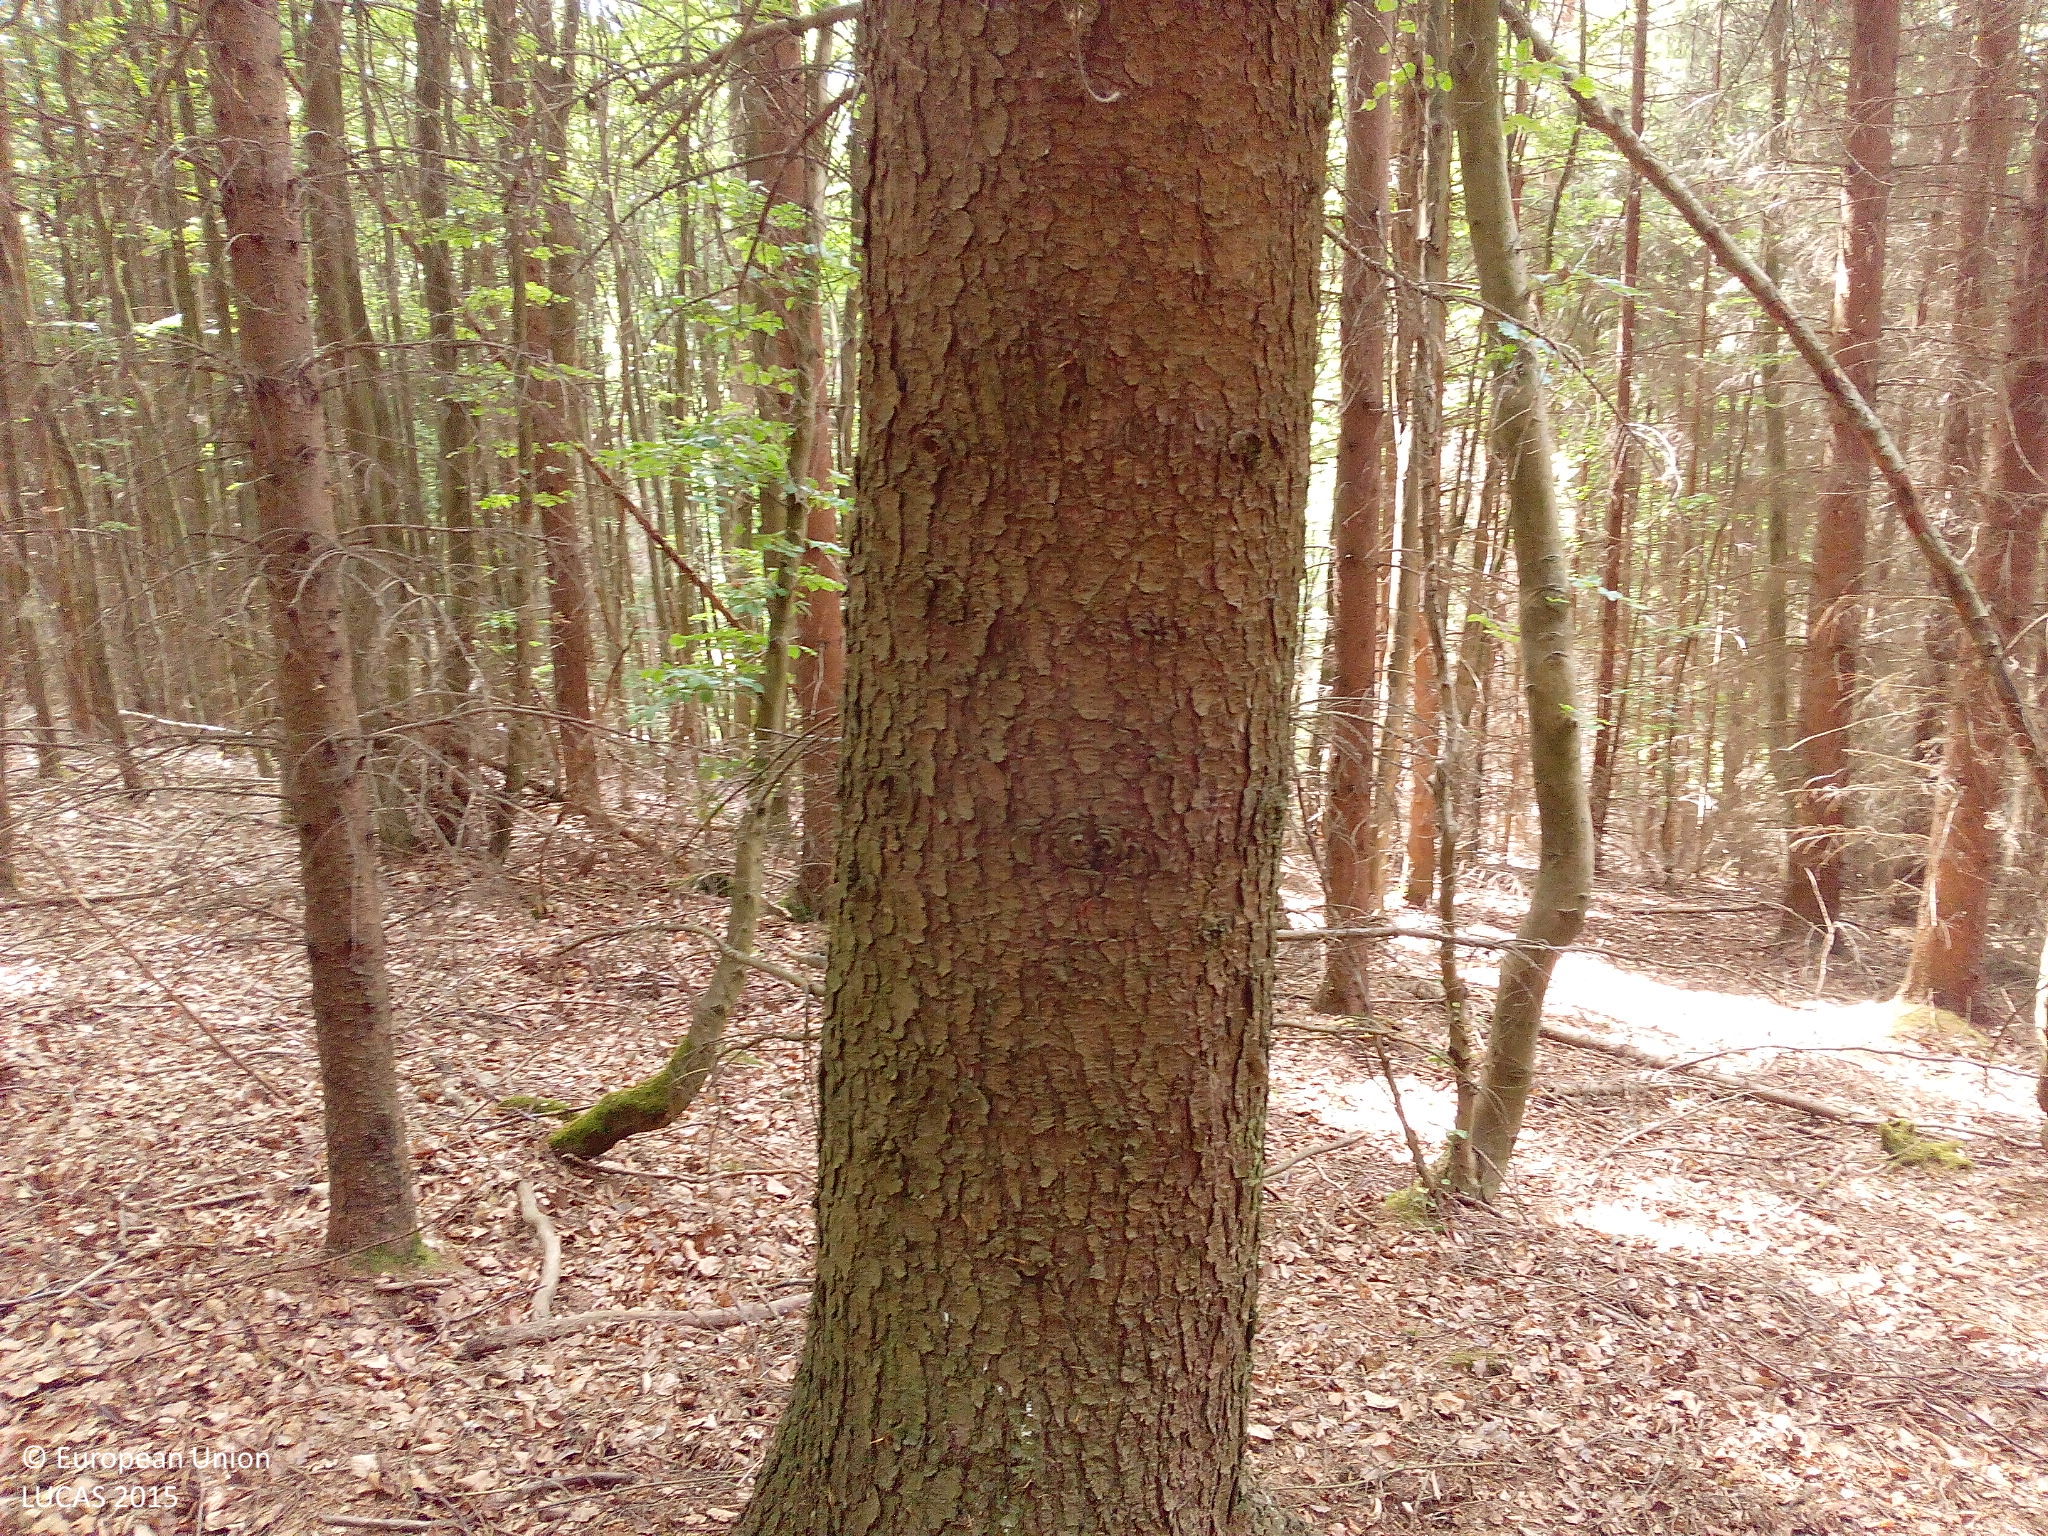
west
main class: Woodland
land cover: Spruce dominated mixed woodland
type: hemiboreal forest and nemoral coniferous forest and mixed broadleaved-coniferous forest
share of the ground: > 75 %
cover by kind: broadleaved forest trees 55 %, coniferous forest trees 45 %
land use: Forestry
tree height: > 5 m
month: June
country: DE
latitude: 50.9015
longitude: 9.3319
